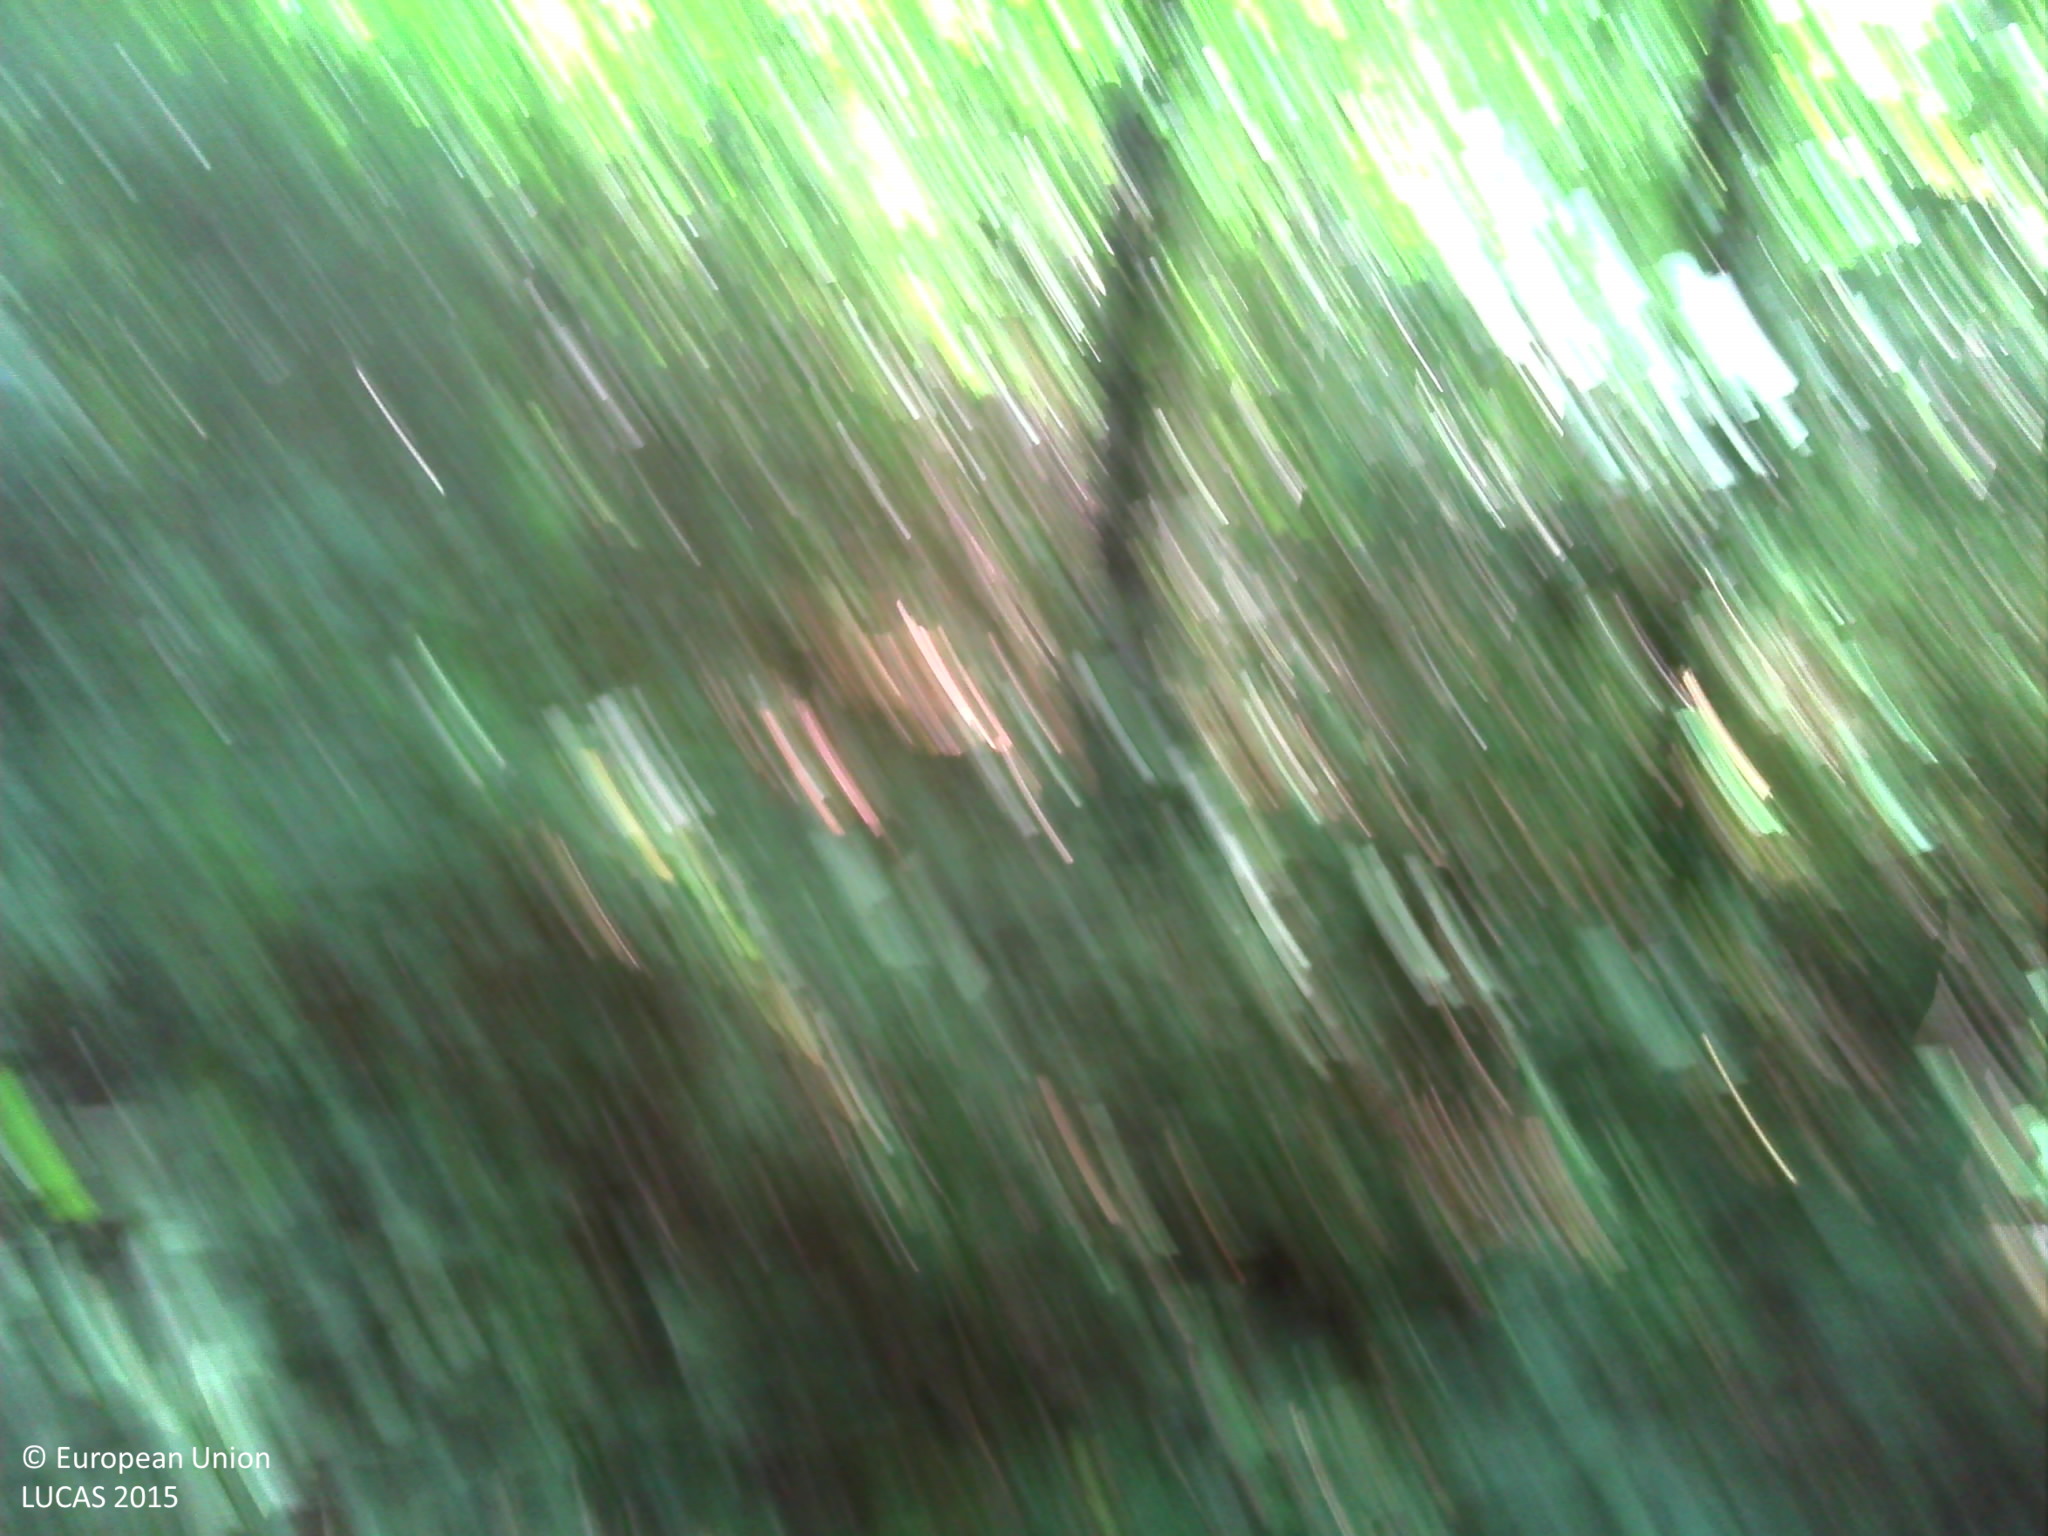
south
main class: Woodland
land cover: Broadleaved woodland
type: mesophytic deciduous forest
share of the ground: > 75 %
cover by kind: broadleaved forest trees 100 %
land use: Forestry
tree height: > 5 m
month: August
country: FR
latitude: 47.1276
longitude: 2.1212
